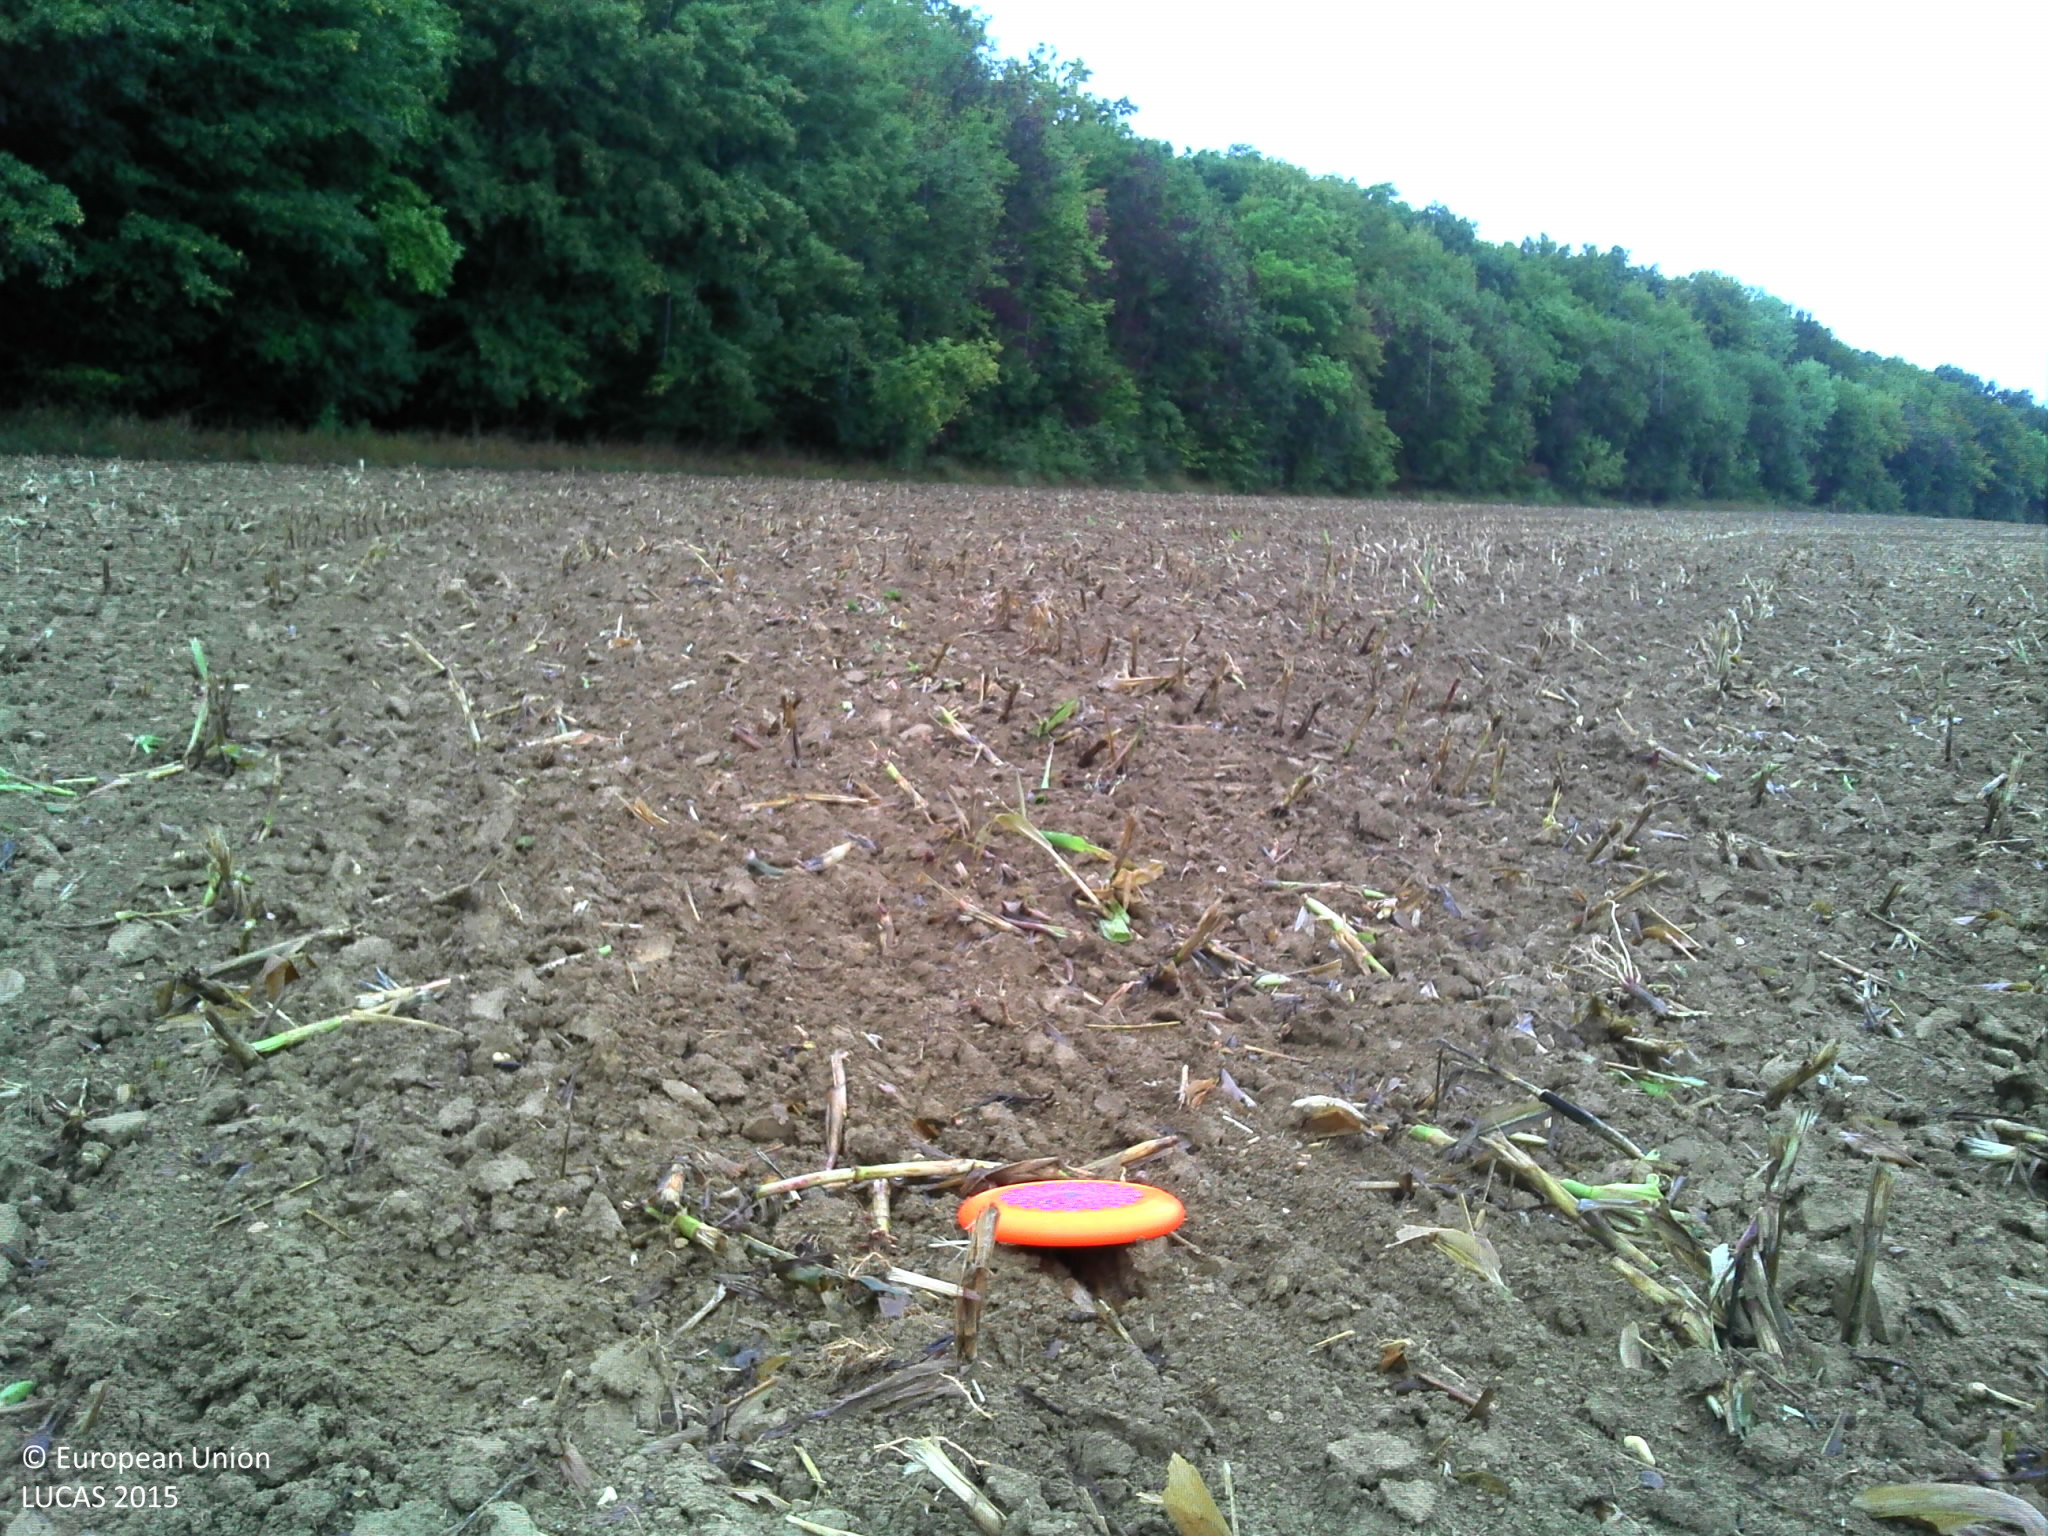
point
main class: Cropland
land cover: Maize
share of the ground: < 10 %
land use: Agriculture (excluding fallow land and kitchen gardens)
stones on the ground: < 10 %
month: September
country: FR
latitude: 49.2269
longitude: 5.8661
